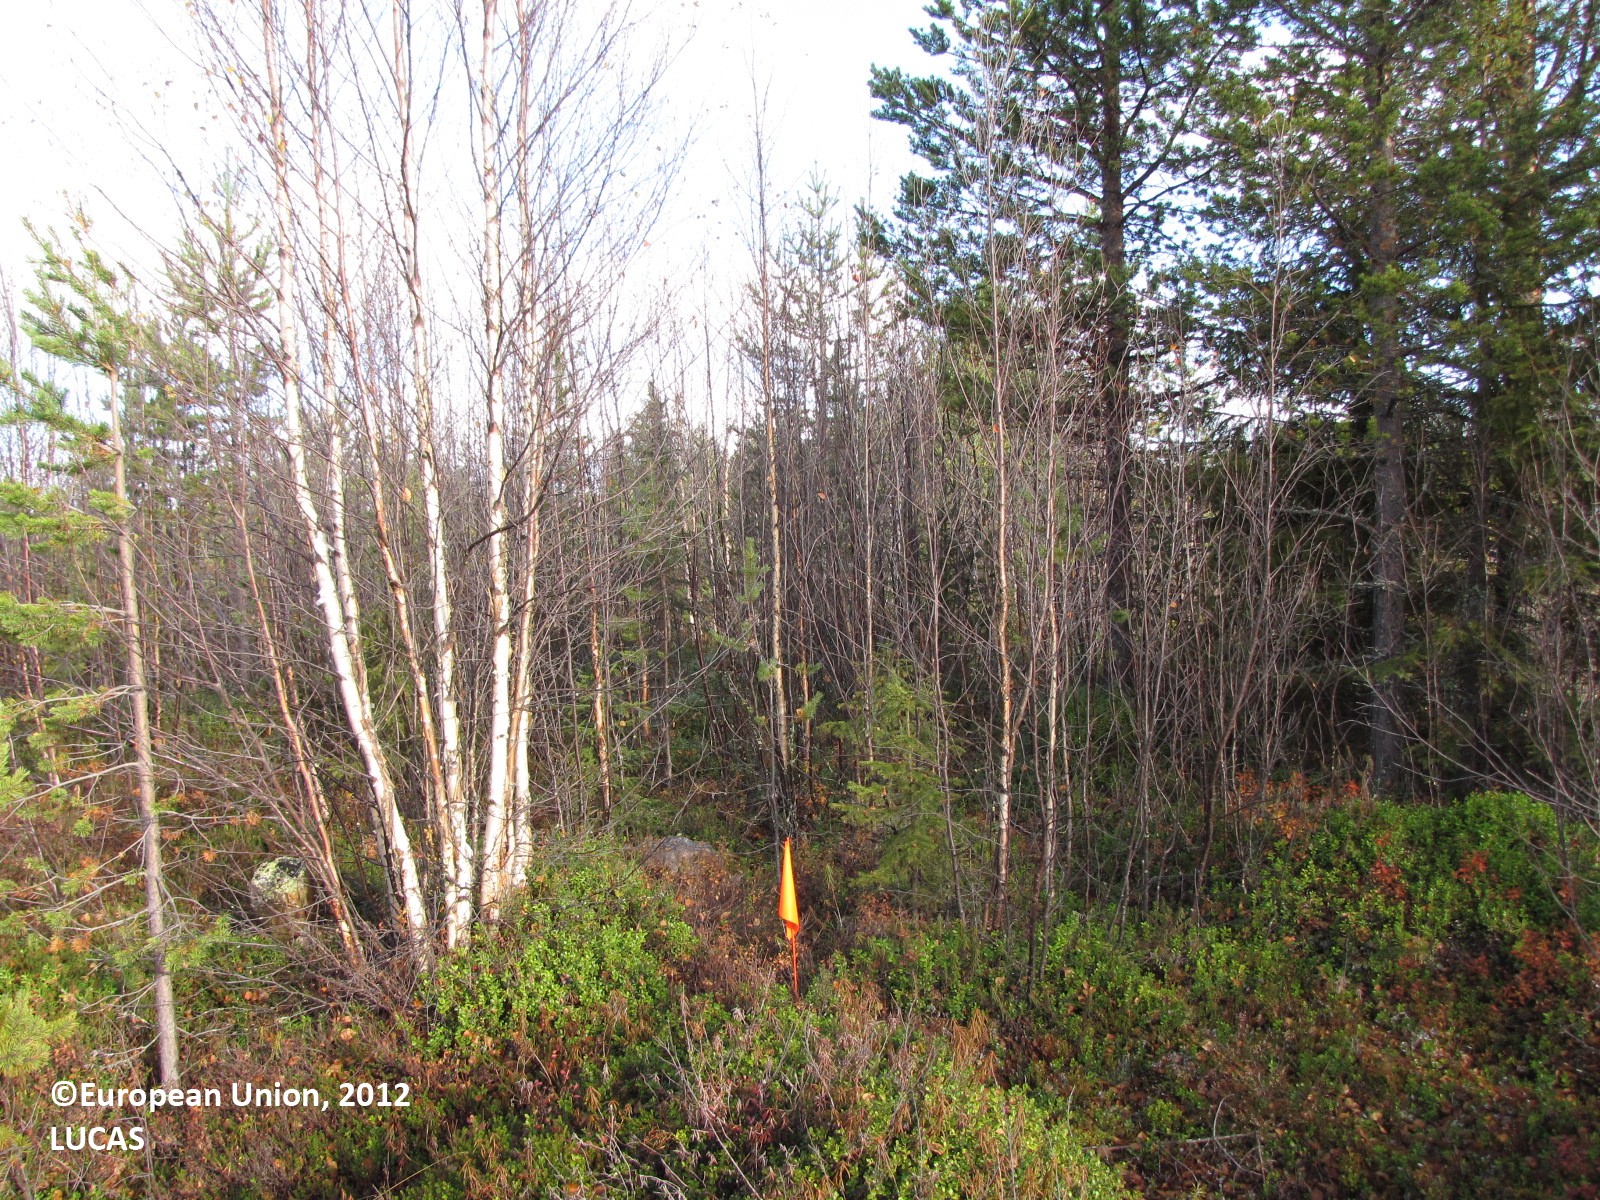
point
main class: Woodland
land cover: Pine dominated mixed woodland
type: boreal forest
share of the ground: 25 - 50 %
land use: Forestry
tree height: > 5 m
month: September
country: FI
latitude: 67.8032
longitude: 23.6525
